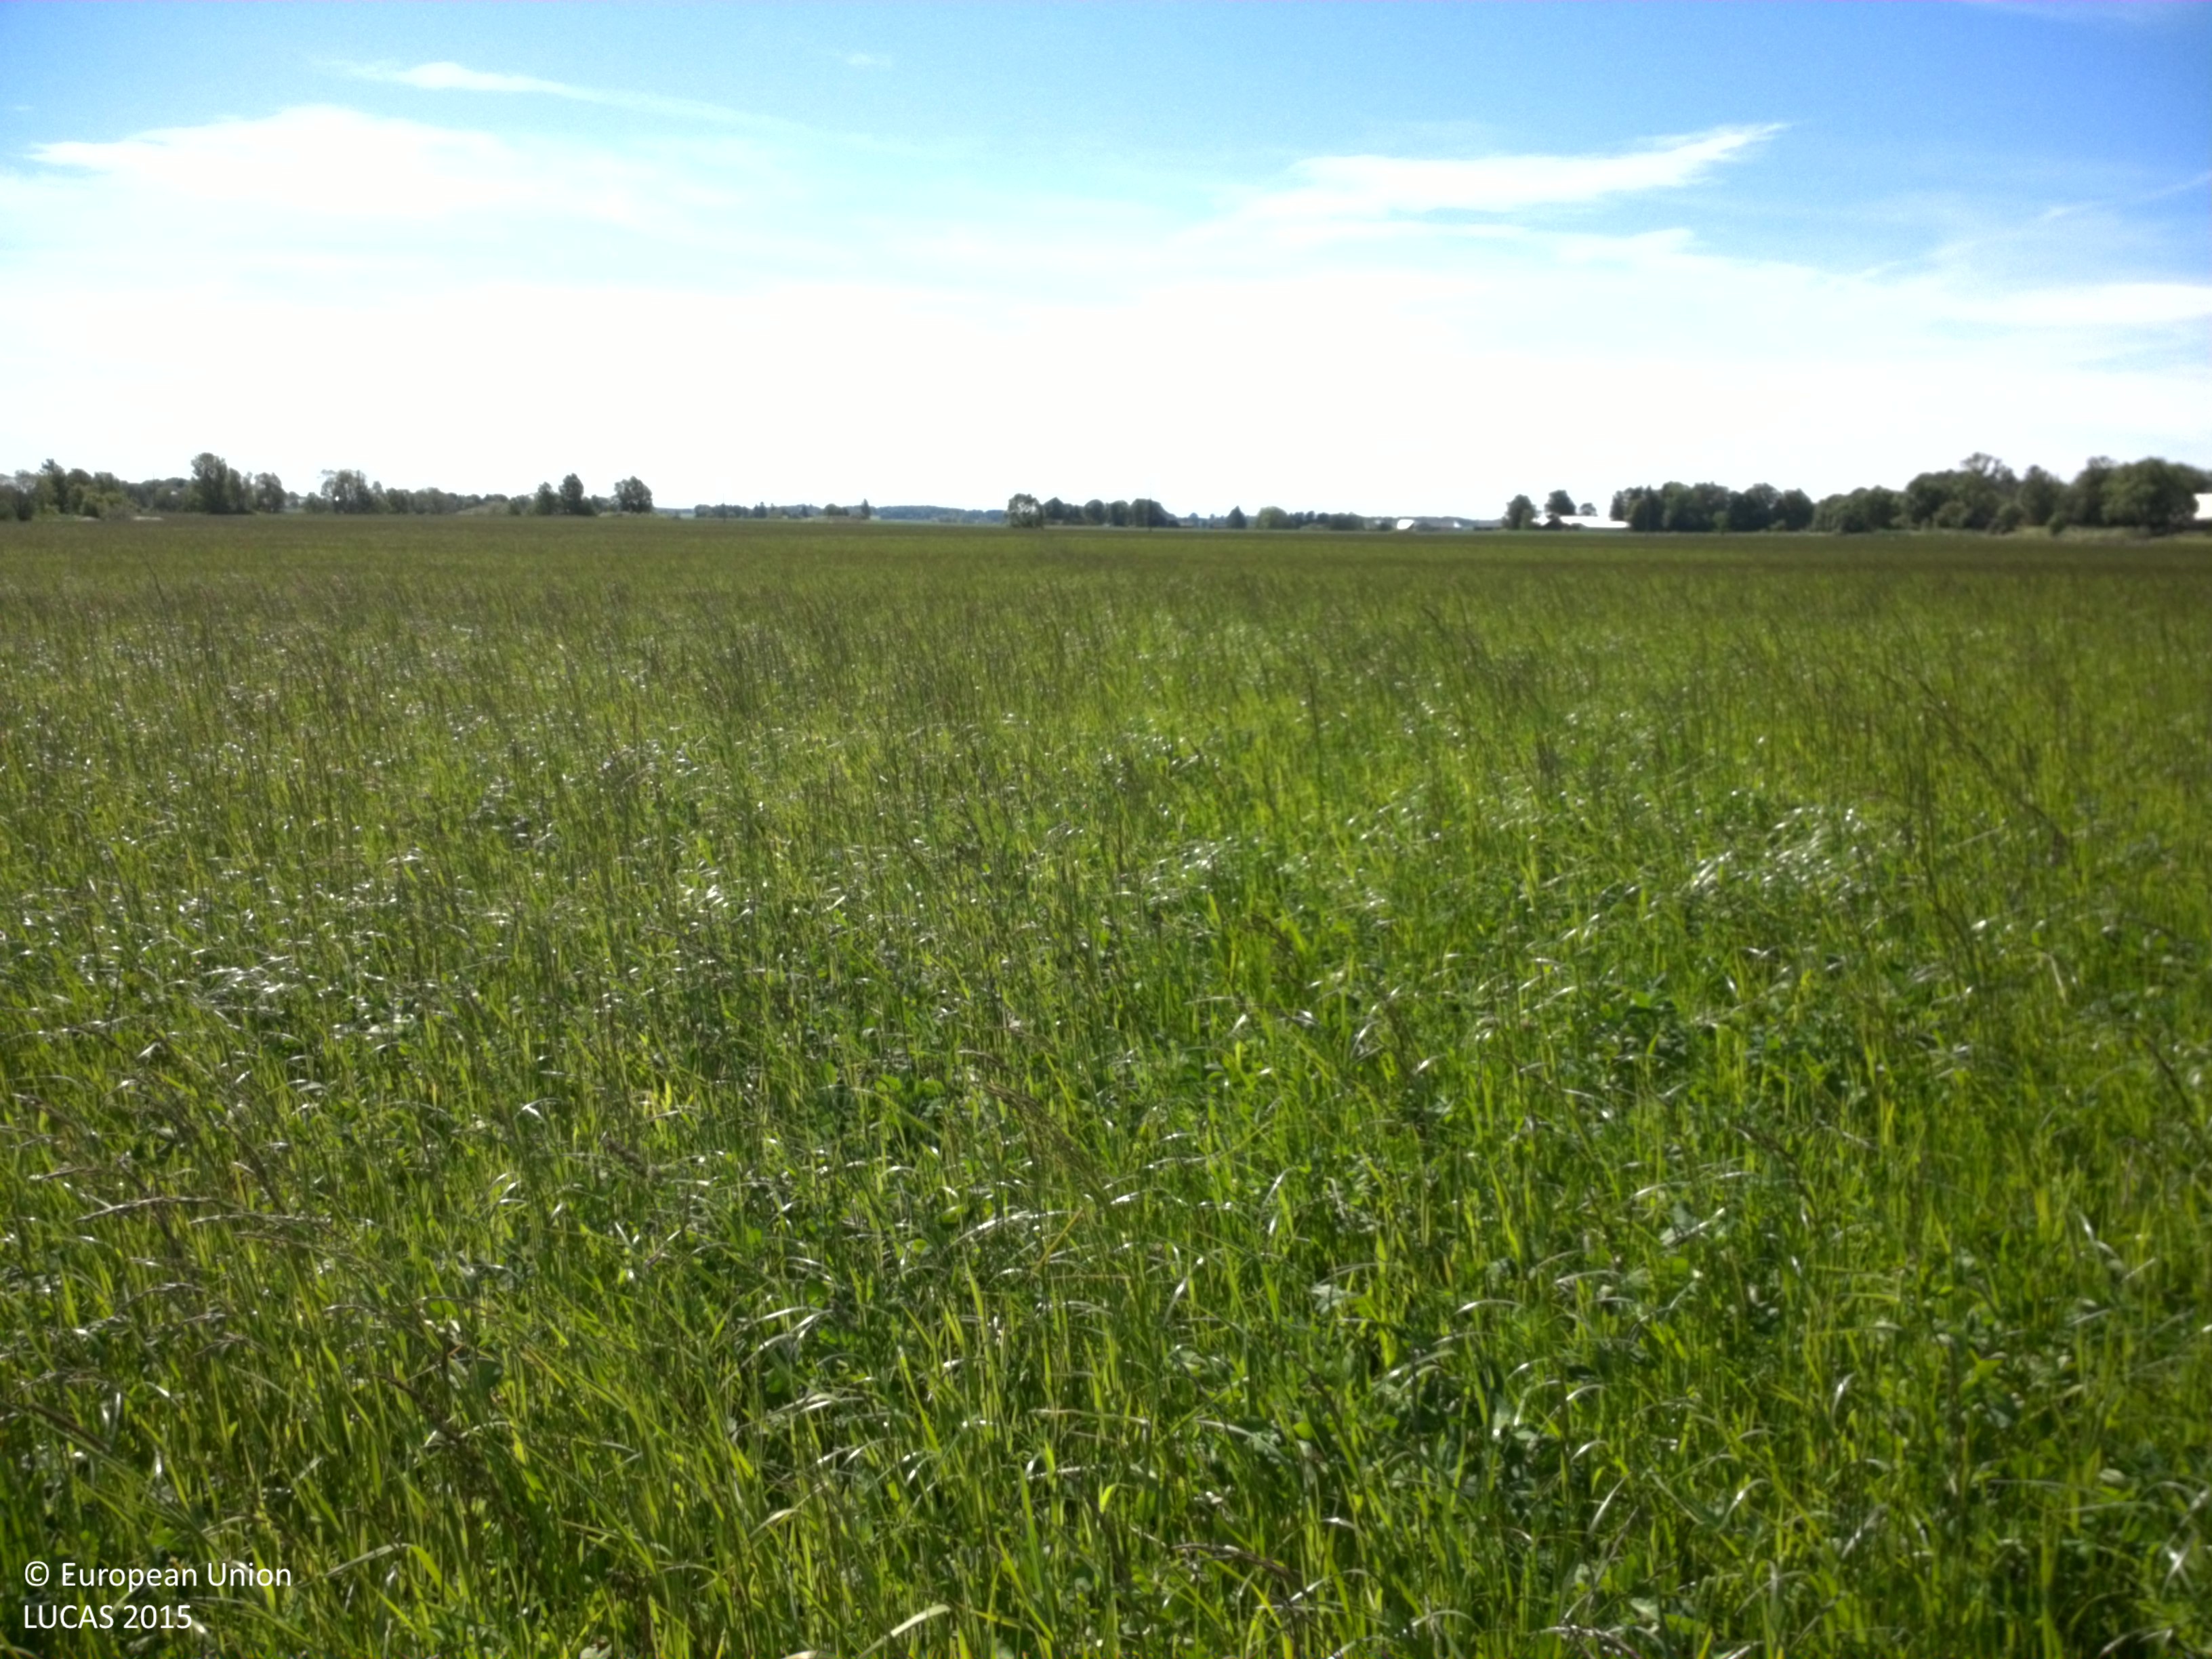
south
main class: Cropland
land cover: Other leguminous and mixtures for fodder
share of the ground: > 75 %
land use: Agriculture (excluding fallow land and kitchen gardens)
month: June
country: SE
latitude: 58.4898
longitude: 15.3977
